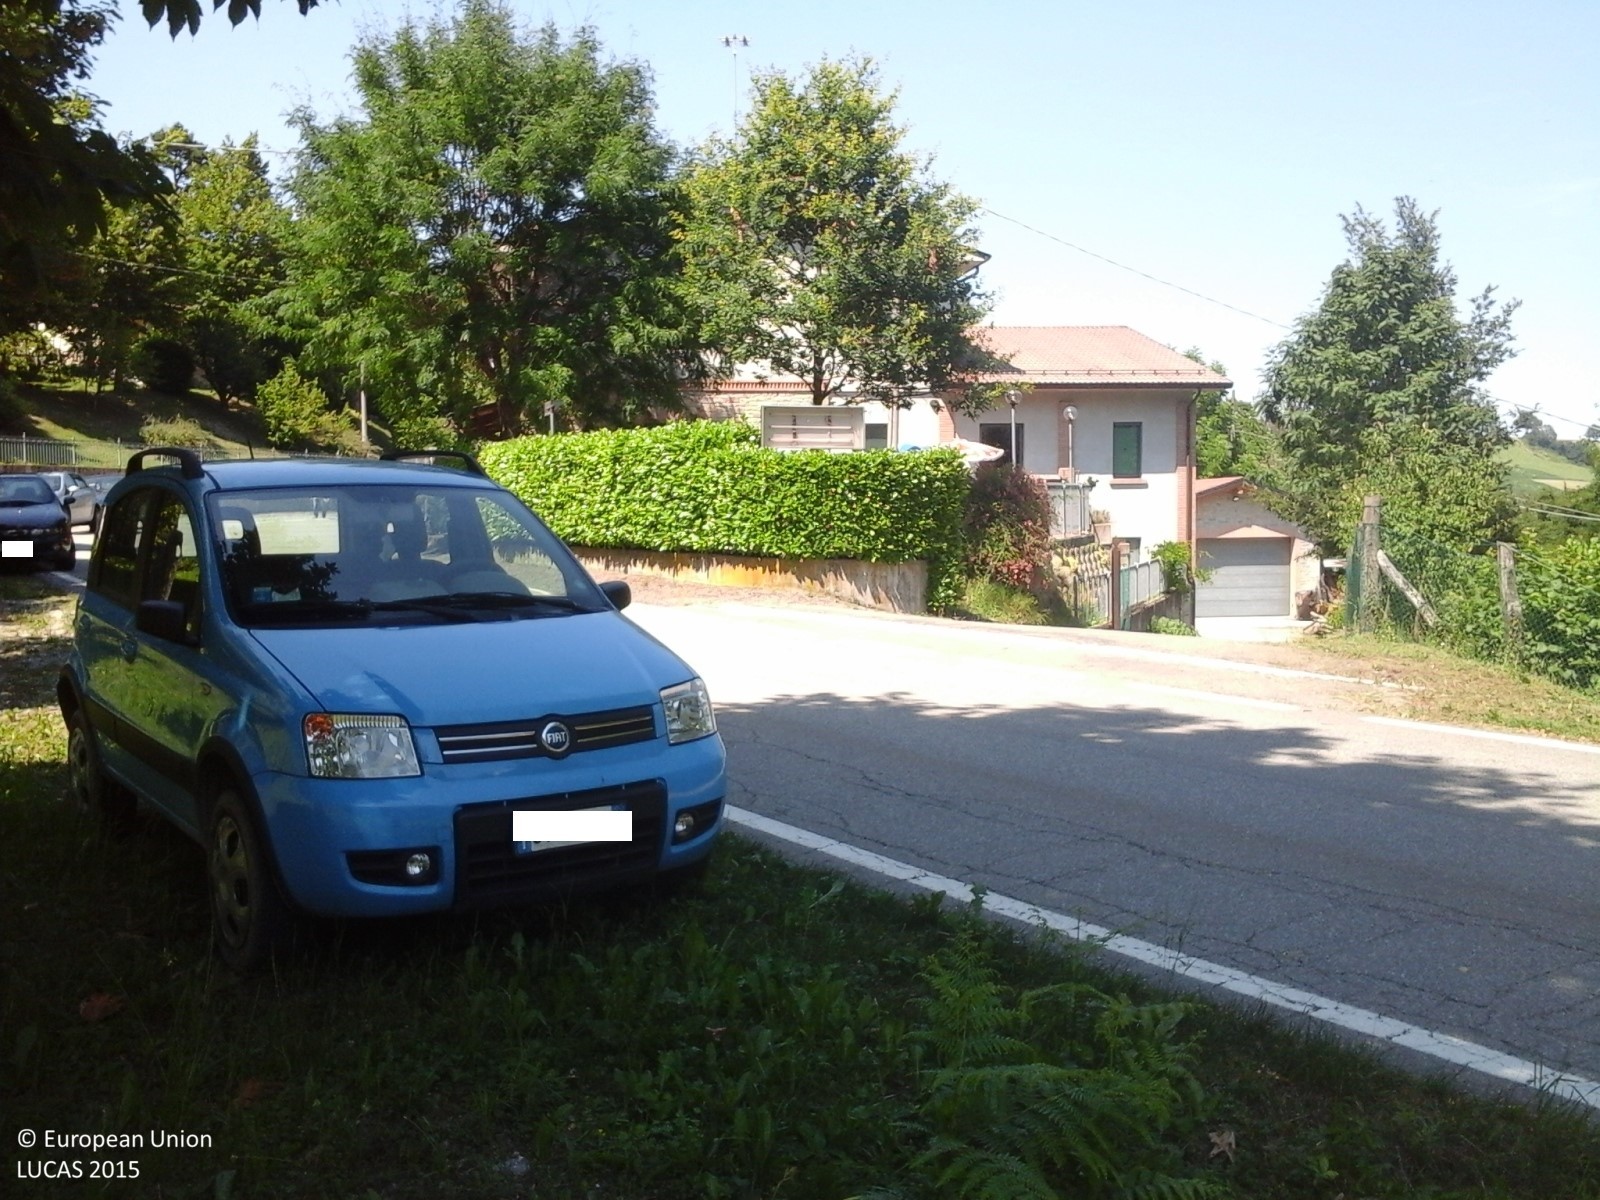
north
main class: Grassland
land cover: Grassland without tree/shrub cover
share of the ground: > 75 %
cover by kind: herbaceous plants 100 %
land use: Residential
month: June
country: IT
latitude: 44.5304
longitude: 10.3139
